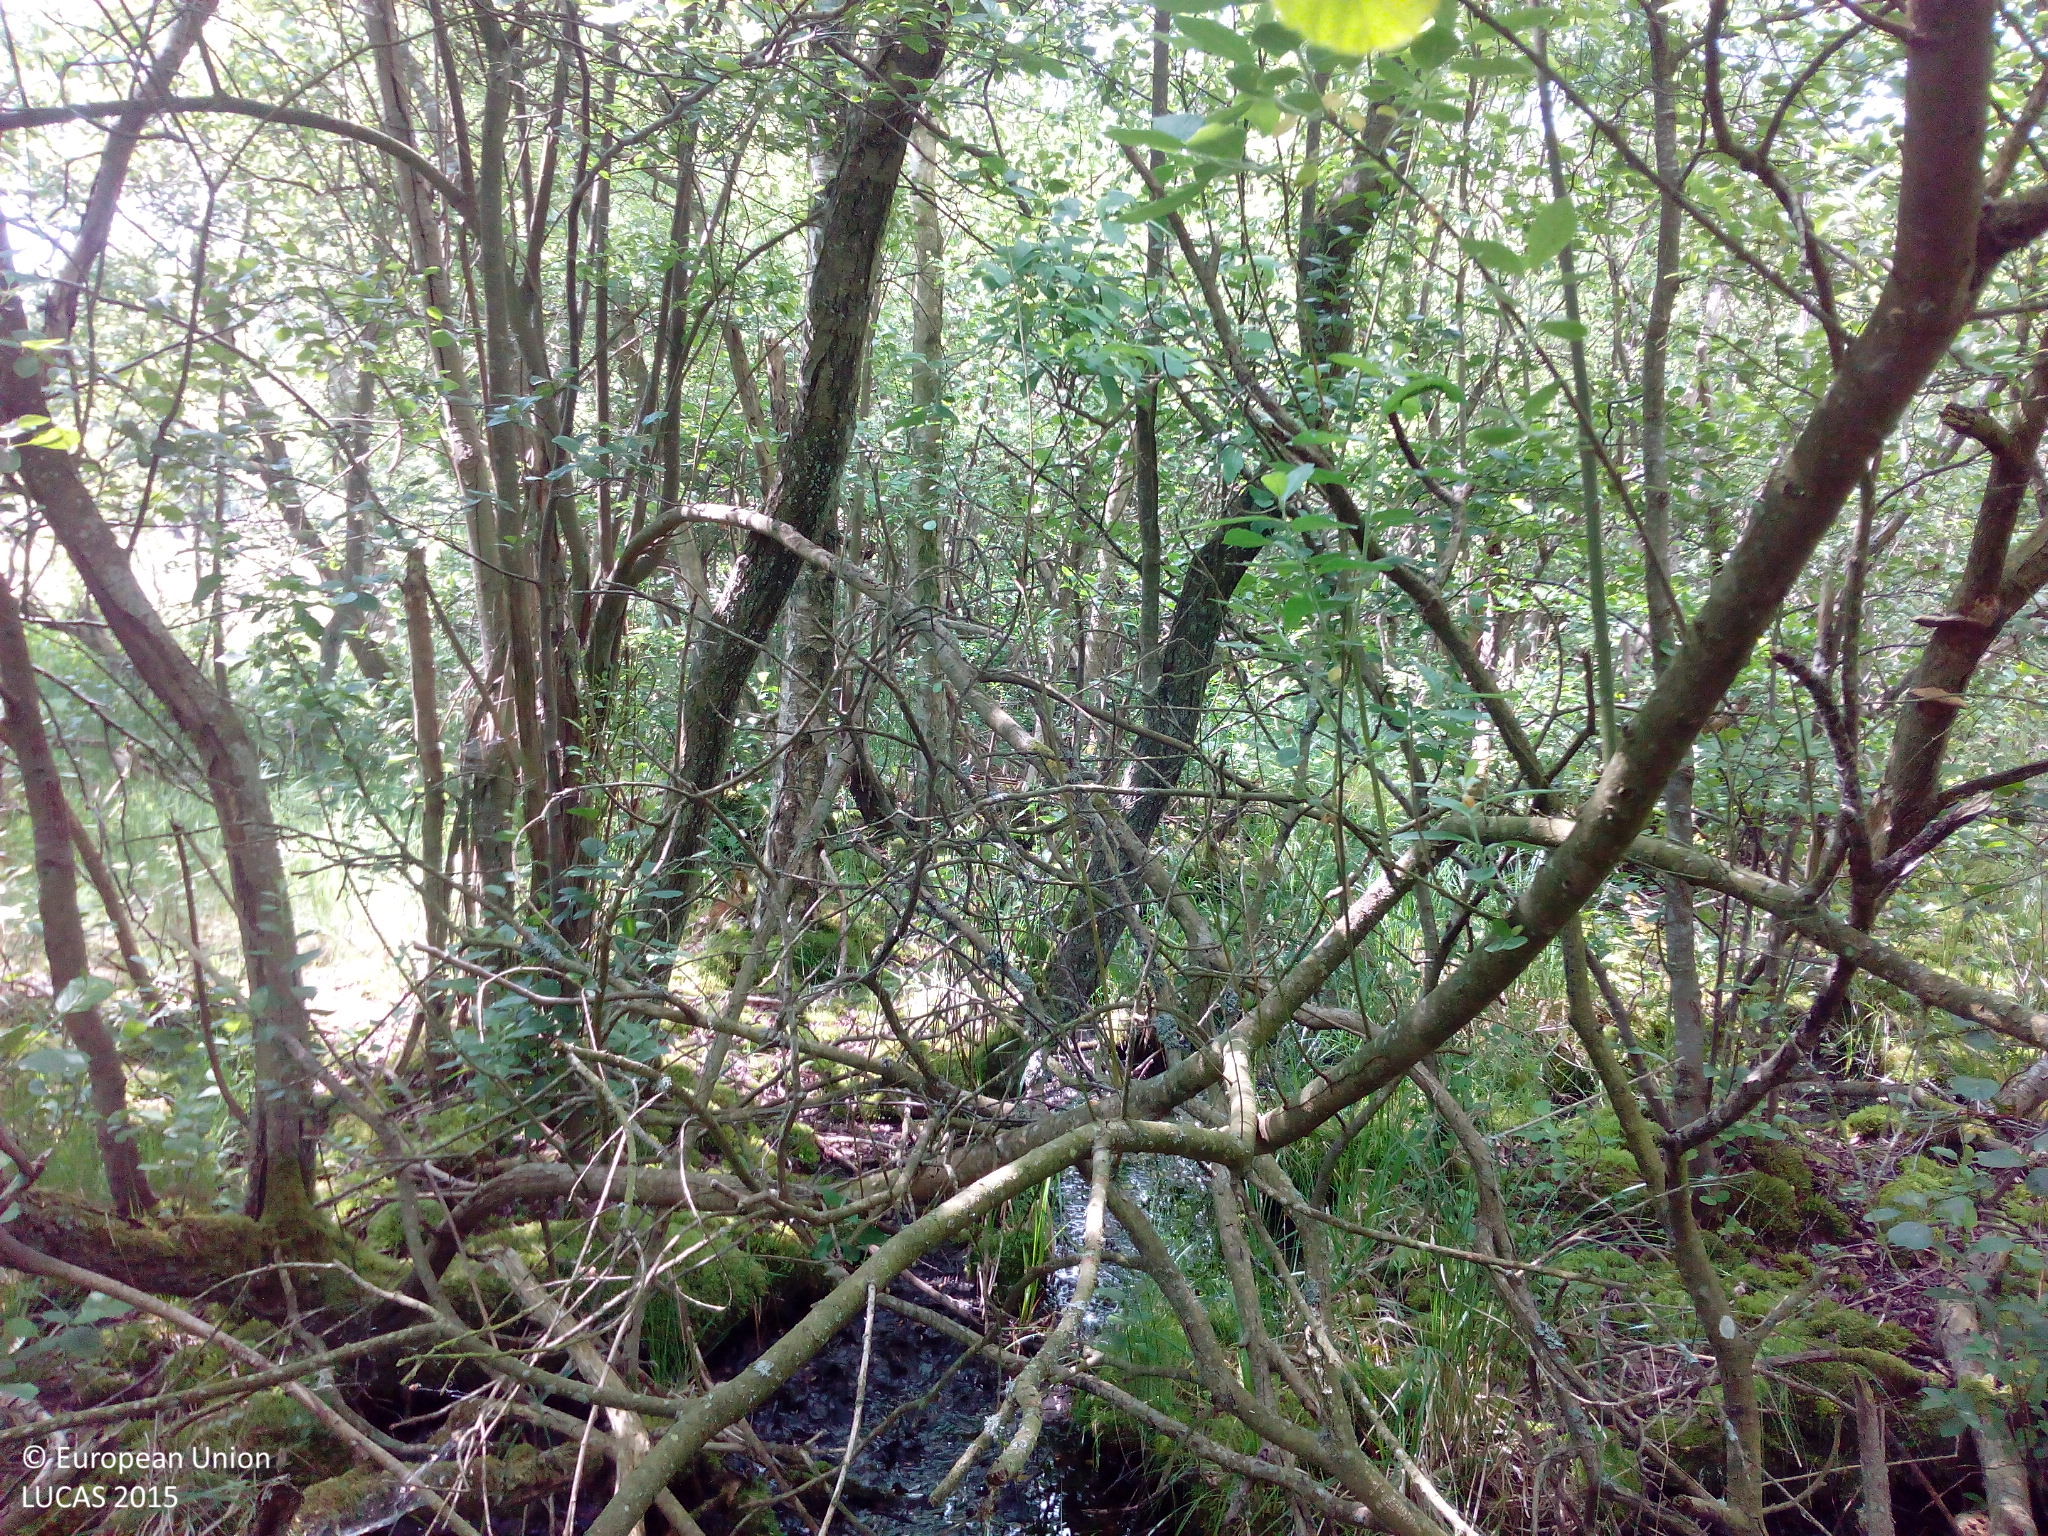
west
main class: Woodland
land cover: Broadleaved woodland
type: mesophytic deciduous forest
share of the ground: 50 - 75 %
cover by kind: broadleaved forest trees 70 %, herbaceous plants 15 %, lichens and mosses 10 %, shrubs 5 %
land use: Semi-natural and natural areas not in use
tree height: > 5 m
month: June
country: DK
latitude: 56.2579
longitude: 10.6610
